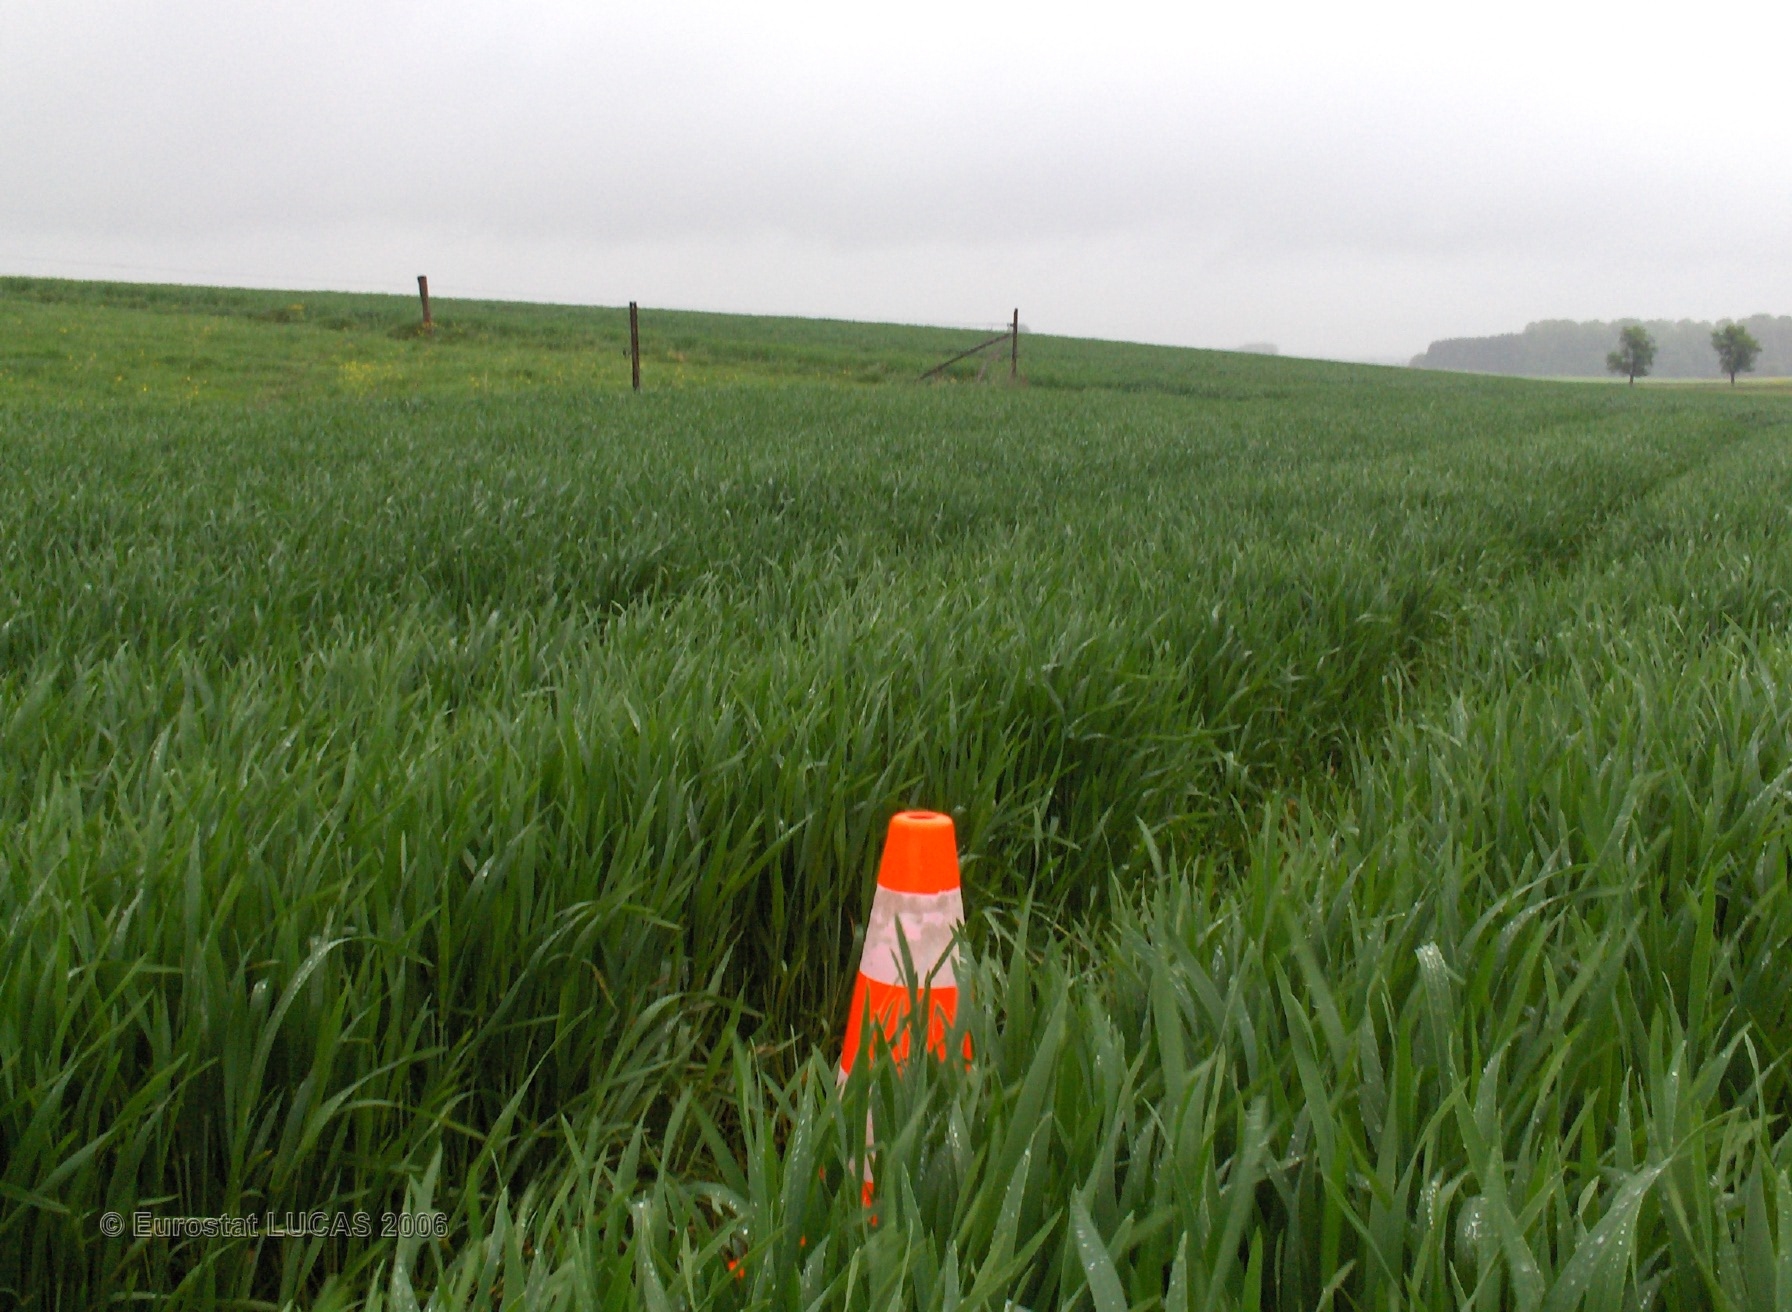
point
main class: Cropland
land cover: Common wheat
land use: Agriculture (excluding fallow land and kitchen gardens)
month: May
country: BE
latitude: 50.3548
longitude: 5.2330
